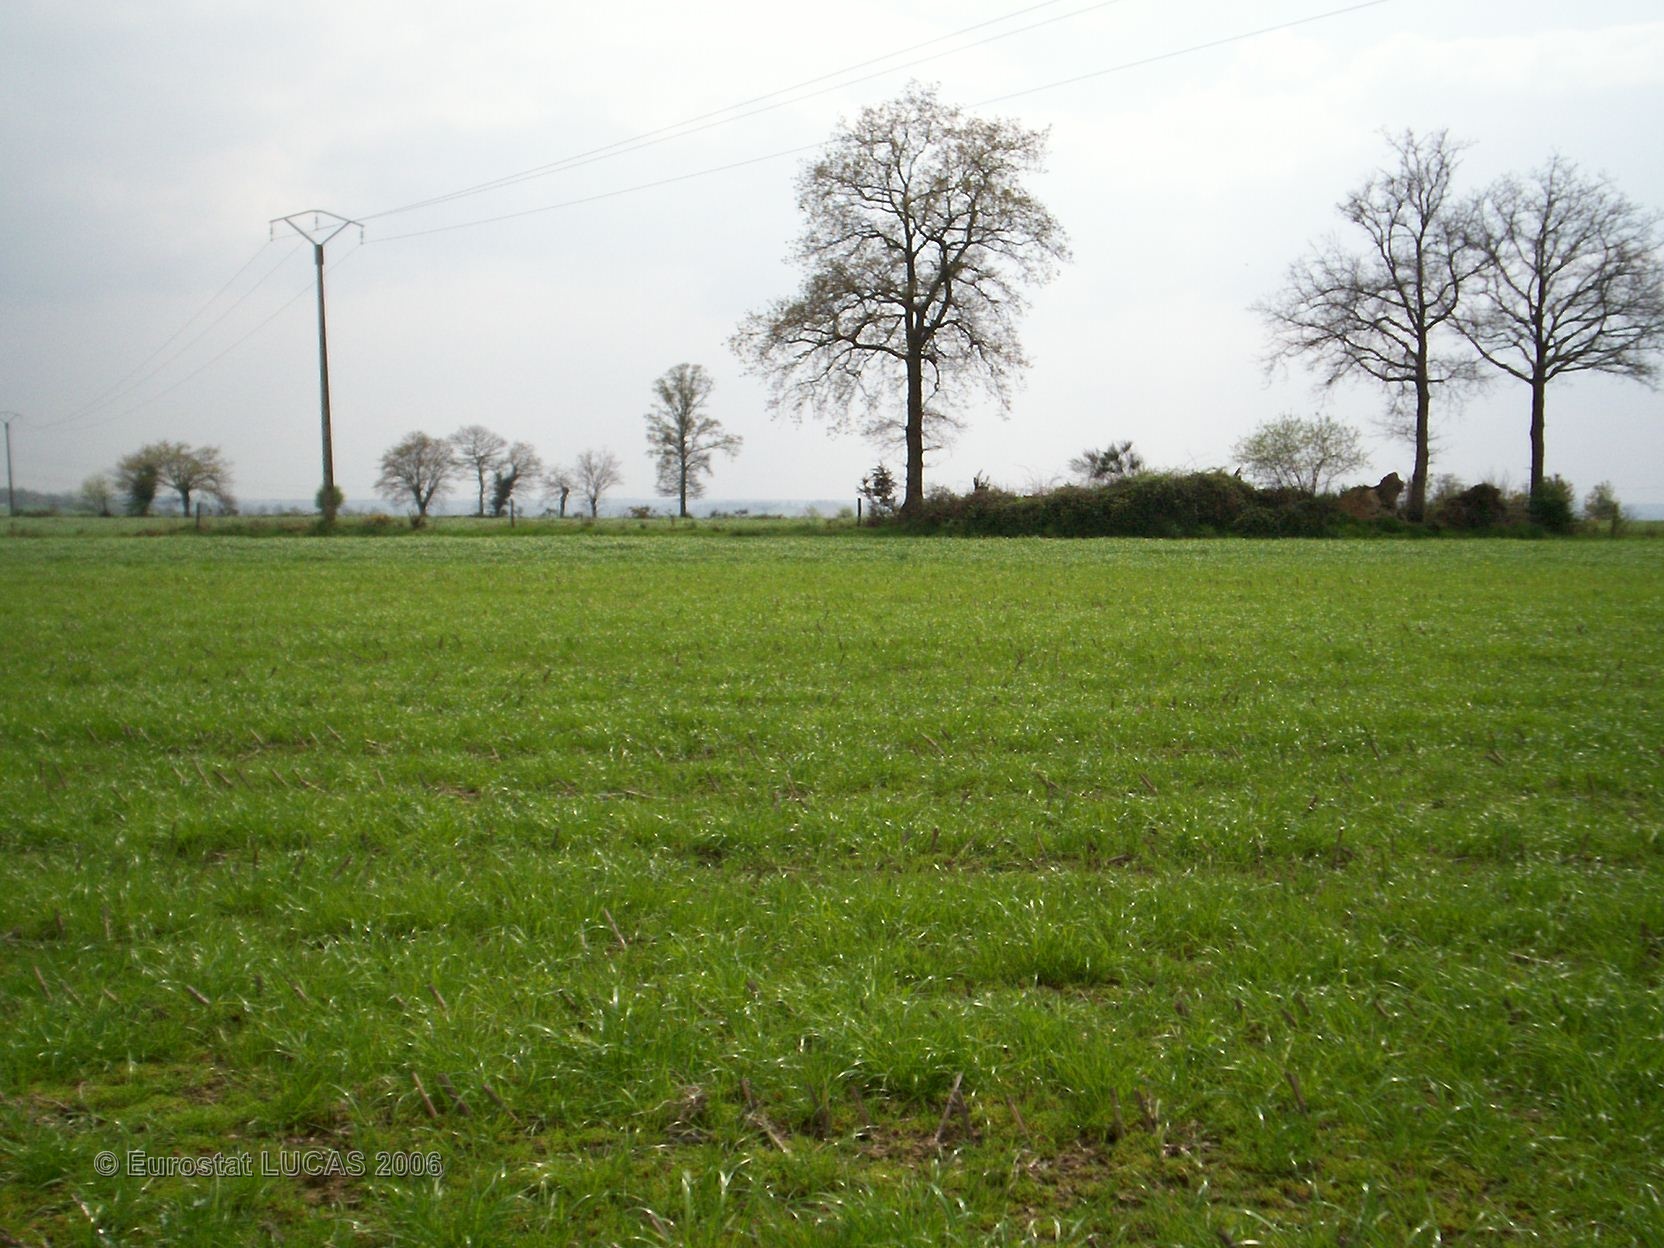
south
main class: Grassland
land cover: Grassland without tree/shrub cover
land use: Agriculture (excluding fallow land and kitchen gardens)
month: April
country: FR
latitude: 48.2331
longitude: -1.3669
